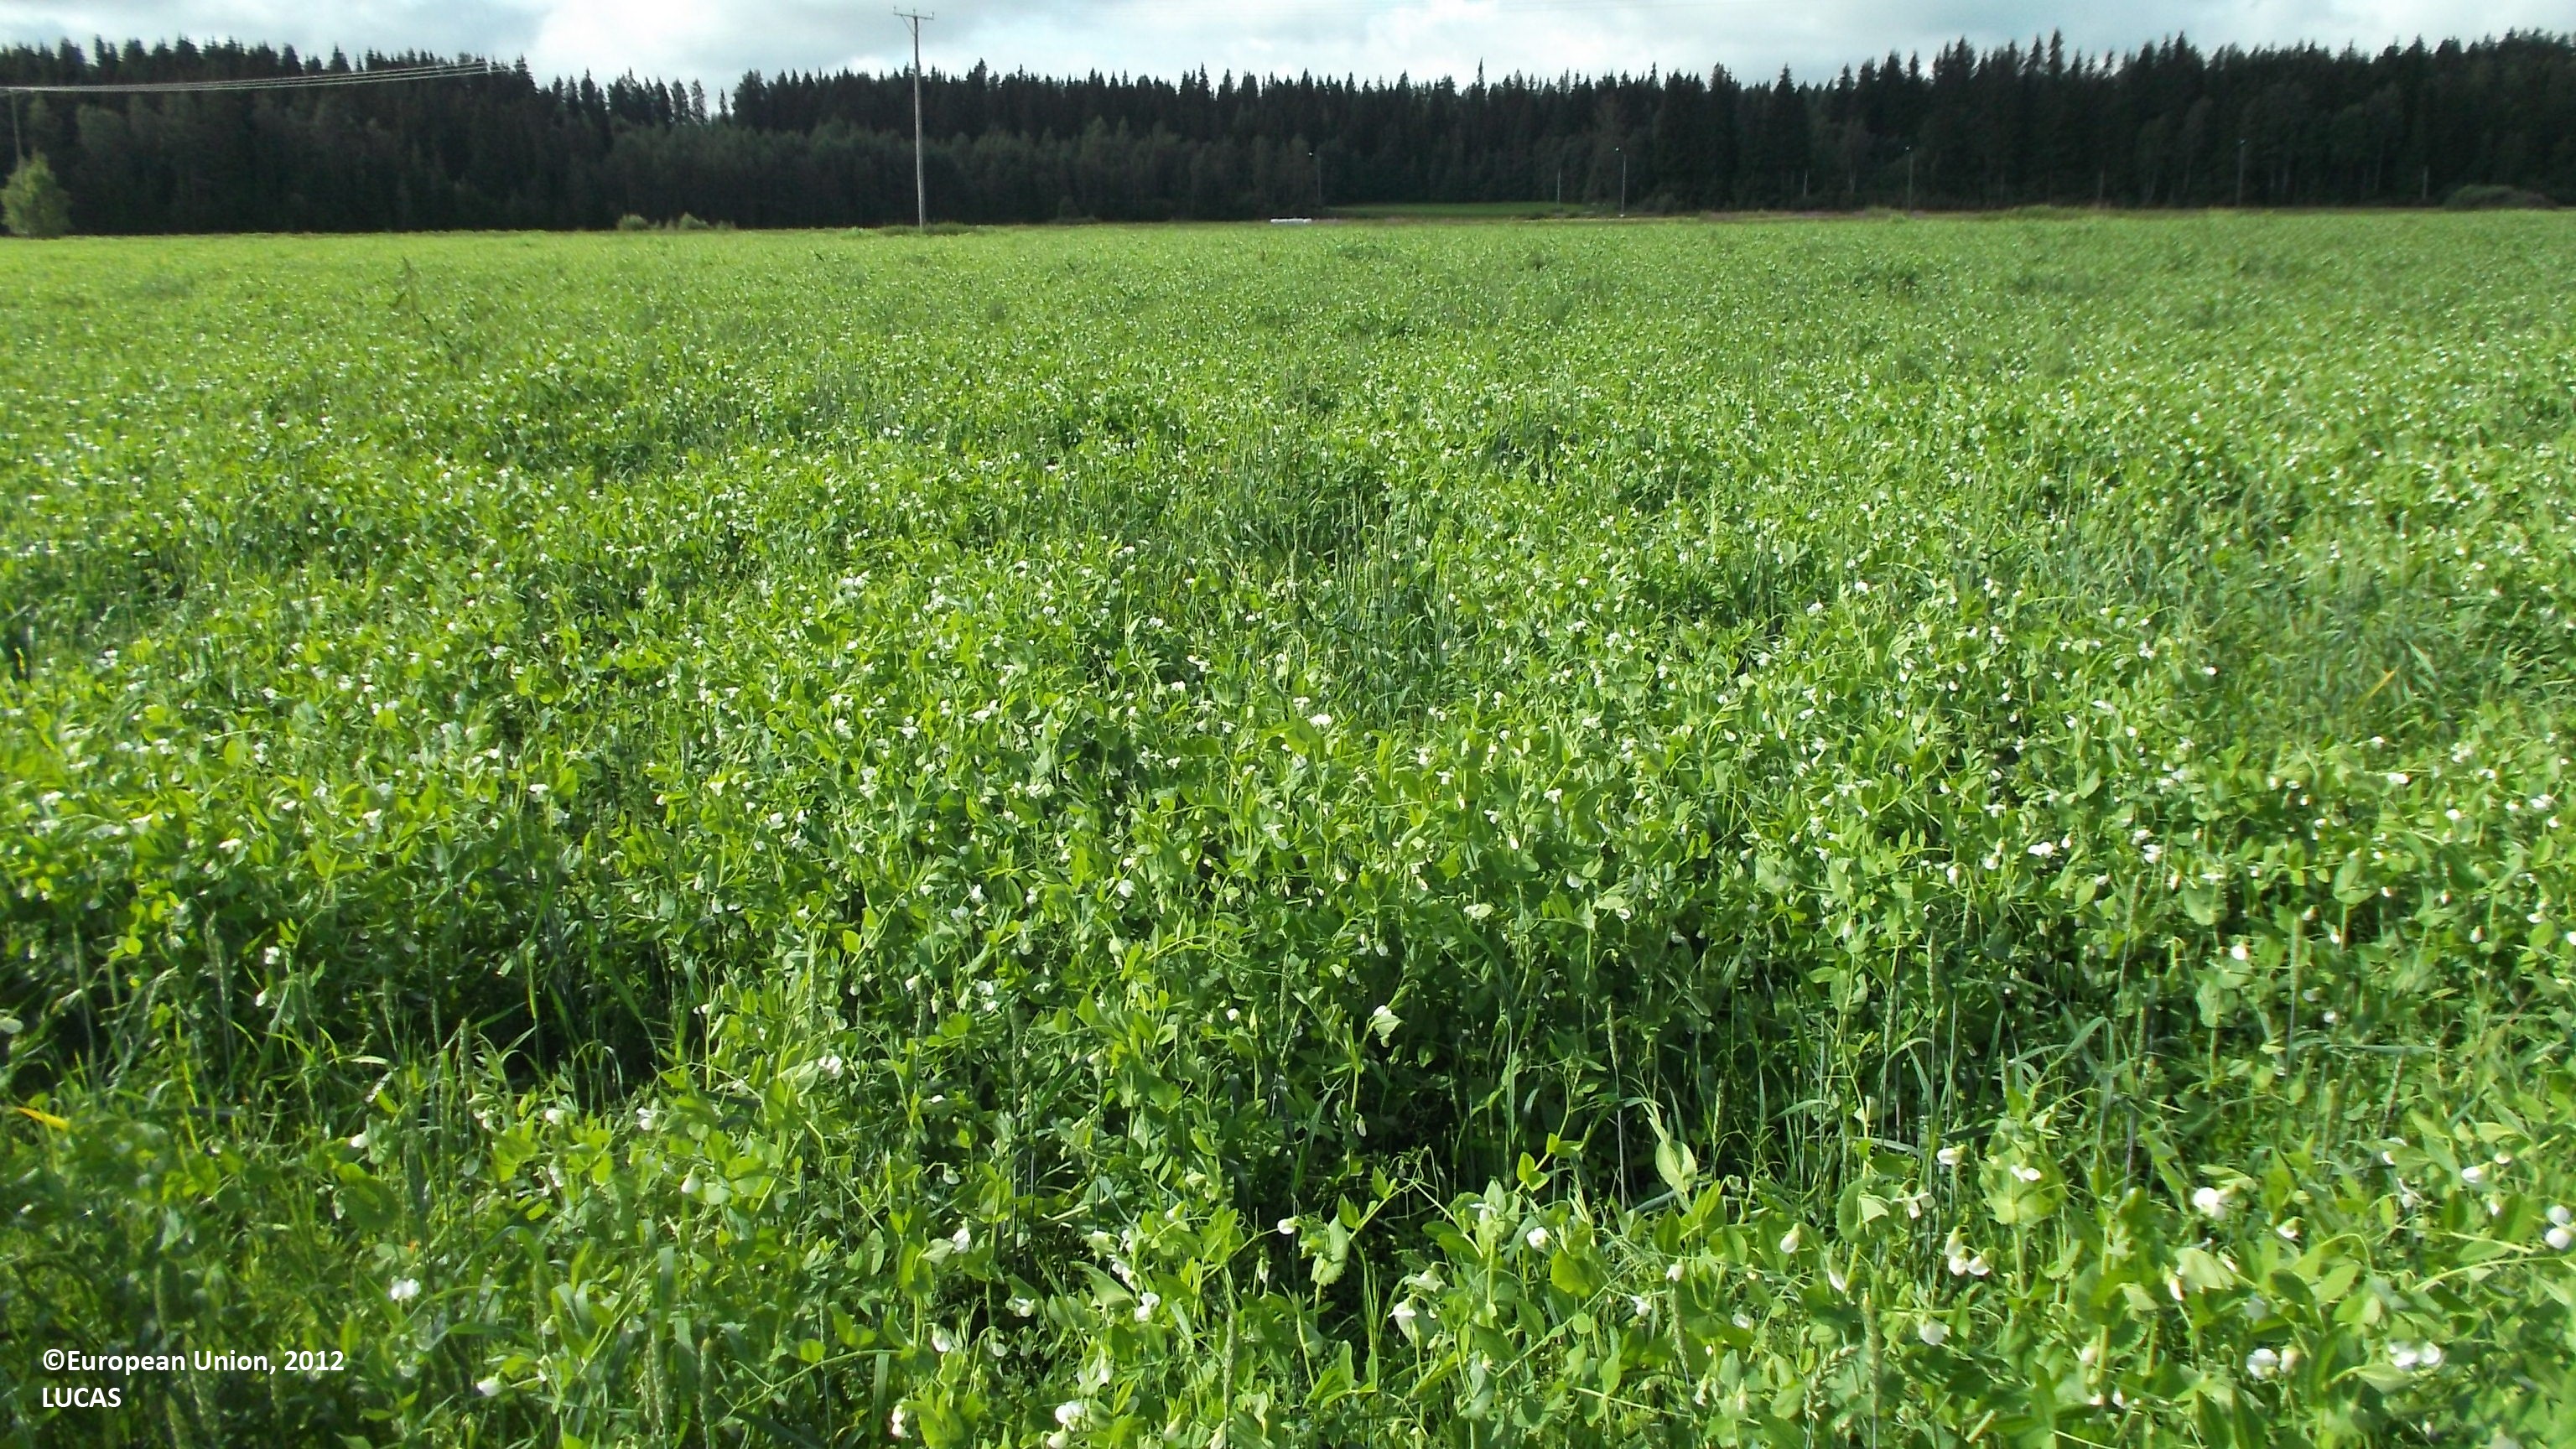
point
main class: Cropland
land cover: Dry pulses
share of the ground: > 75 %
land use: Agriculture (excluding fallow land and kitchen gardens)
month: August
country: FI
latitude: 63.8790
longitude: 23.4323
